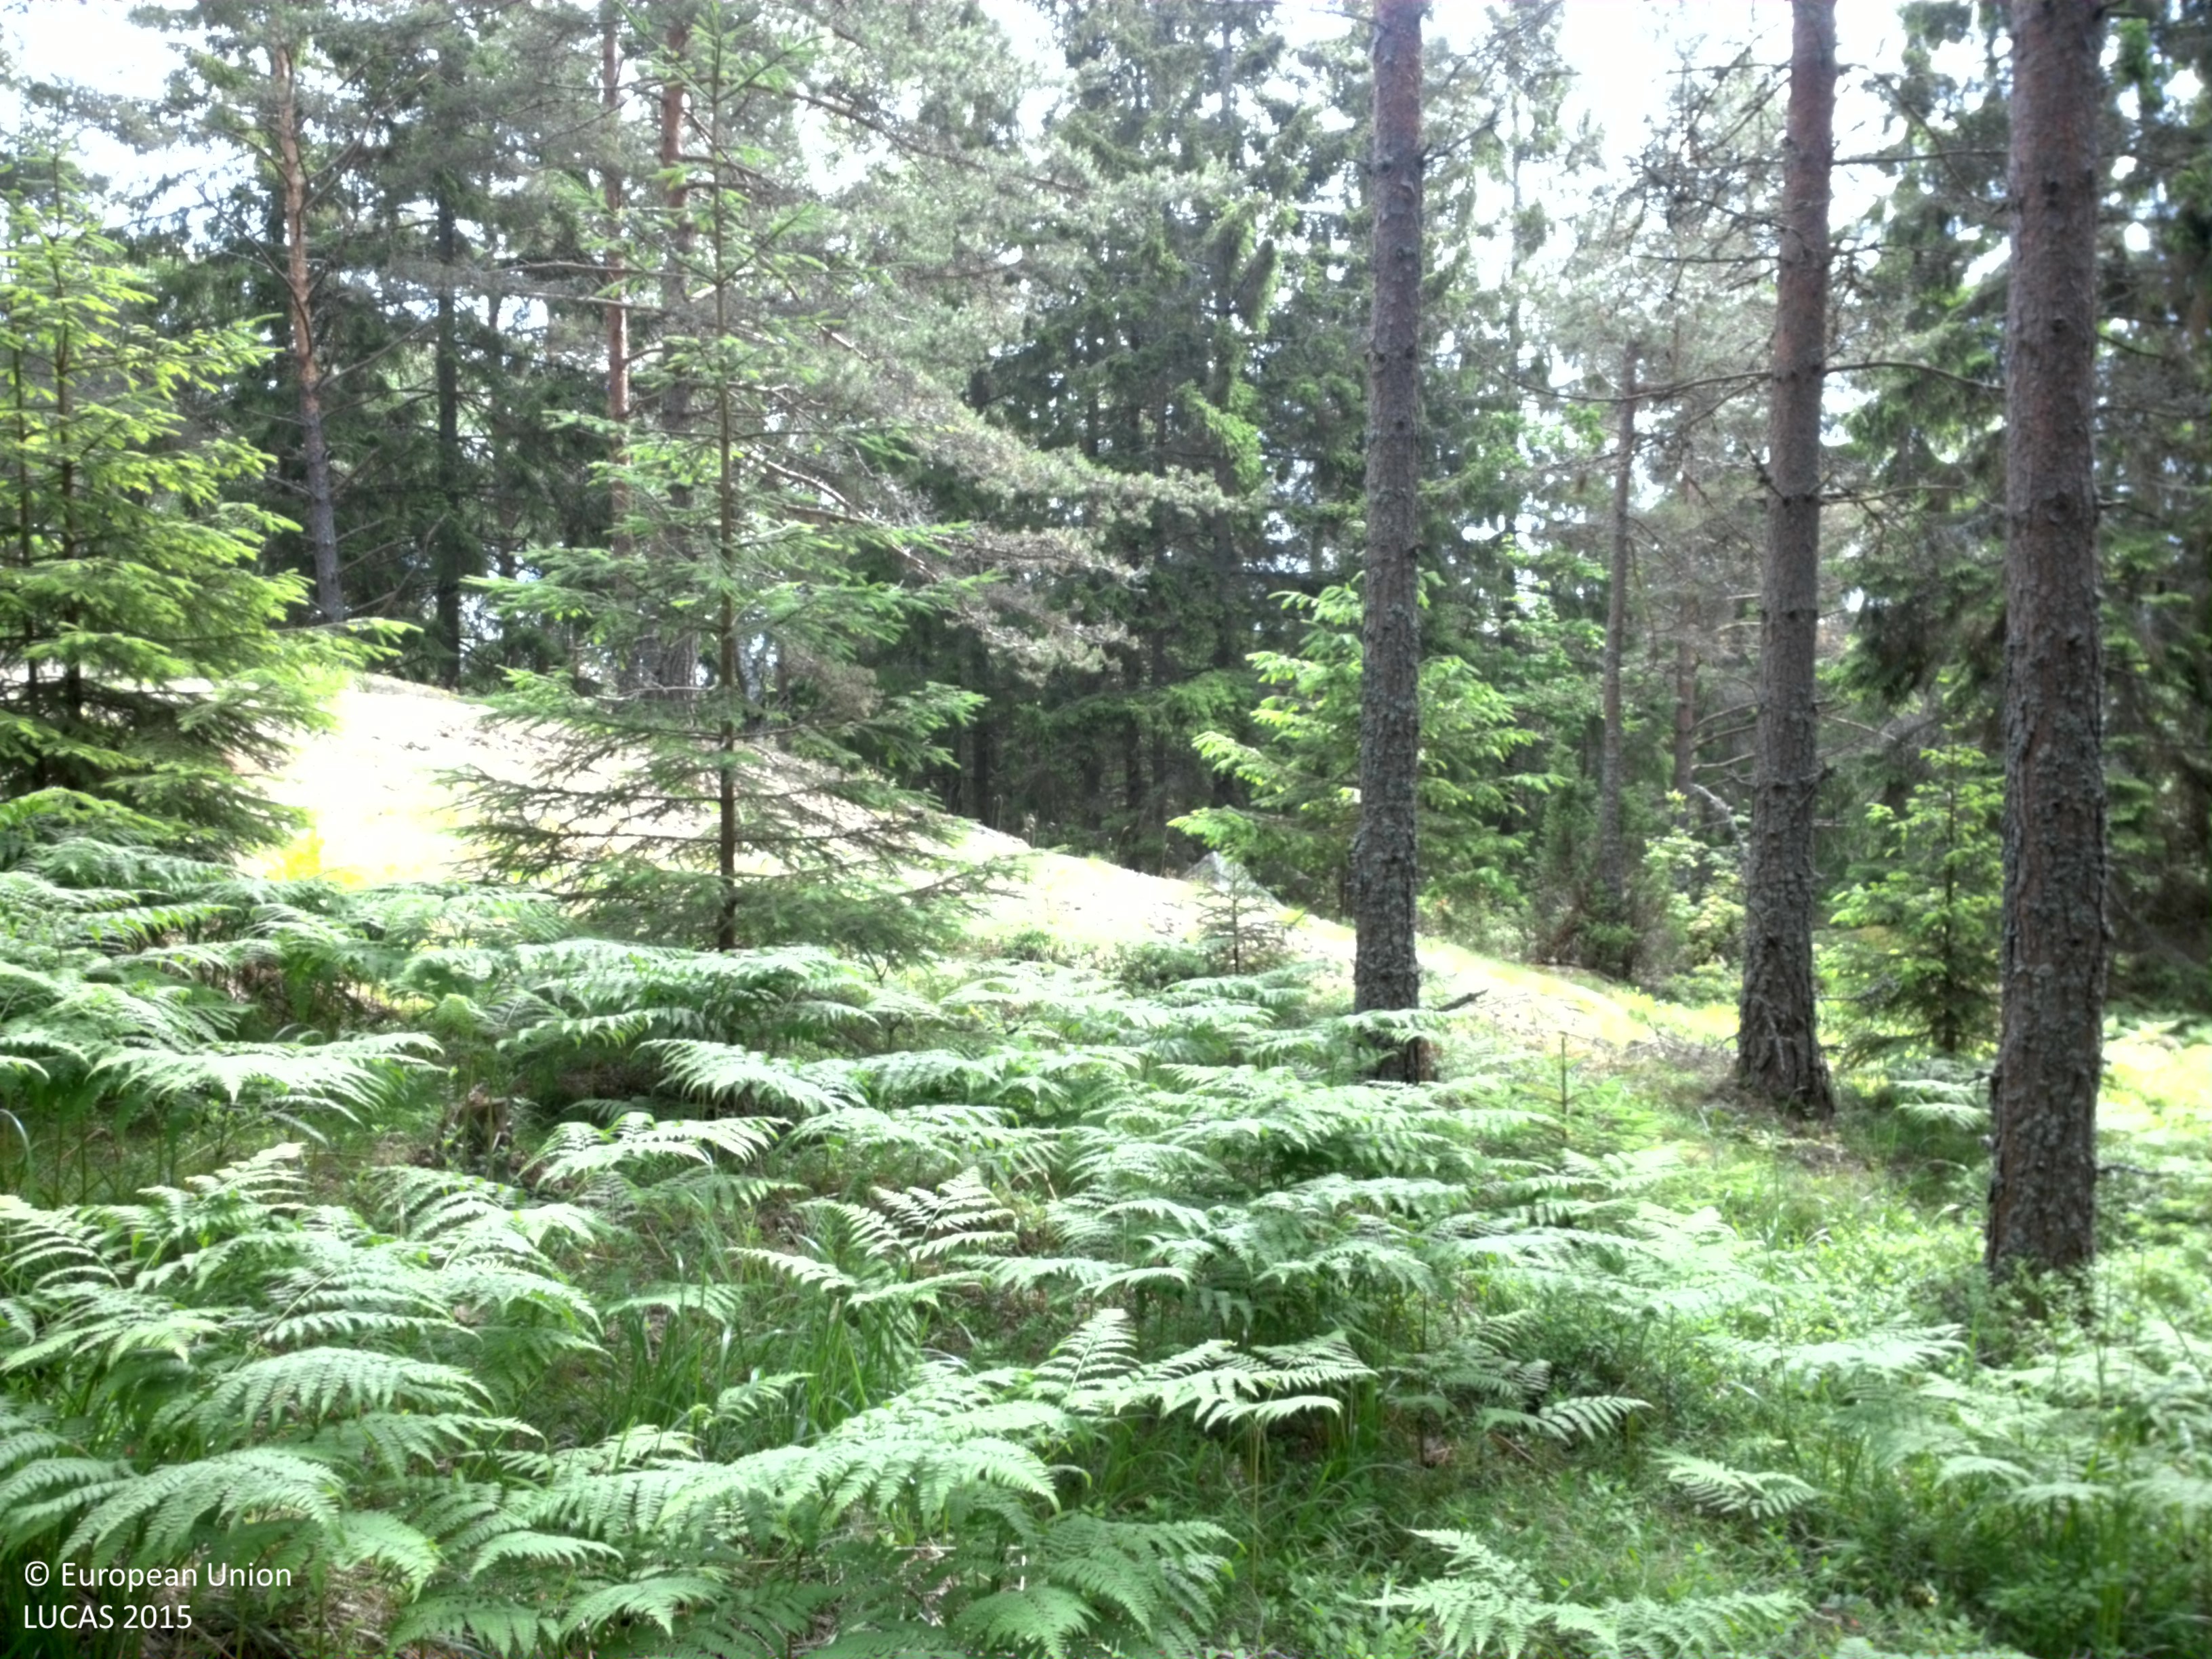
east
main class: Woodland
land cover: Pine dominated coniferous woodland
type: boreal forest
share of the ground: 25 - 50 %
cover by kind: herbaceous plants 55 %, coniferous forest trees 35 %, lichens and mosses 10 %
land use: Forestry
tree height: > 5 m
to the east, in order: Pine dominated coniferous woodland; Spruce dominated coniferous woodland; Ditches and canals; Spruce dominated coniferous woodland; Pine dominated coniferous woodland; Spruce dominated mixed woodland
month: June
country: SE
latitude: 58.5697
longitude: 15.6508
